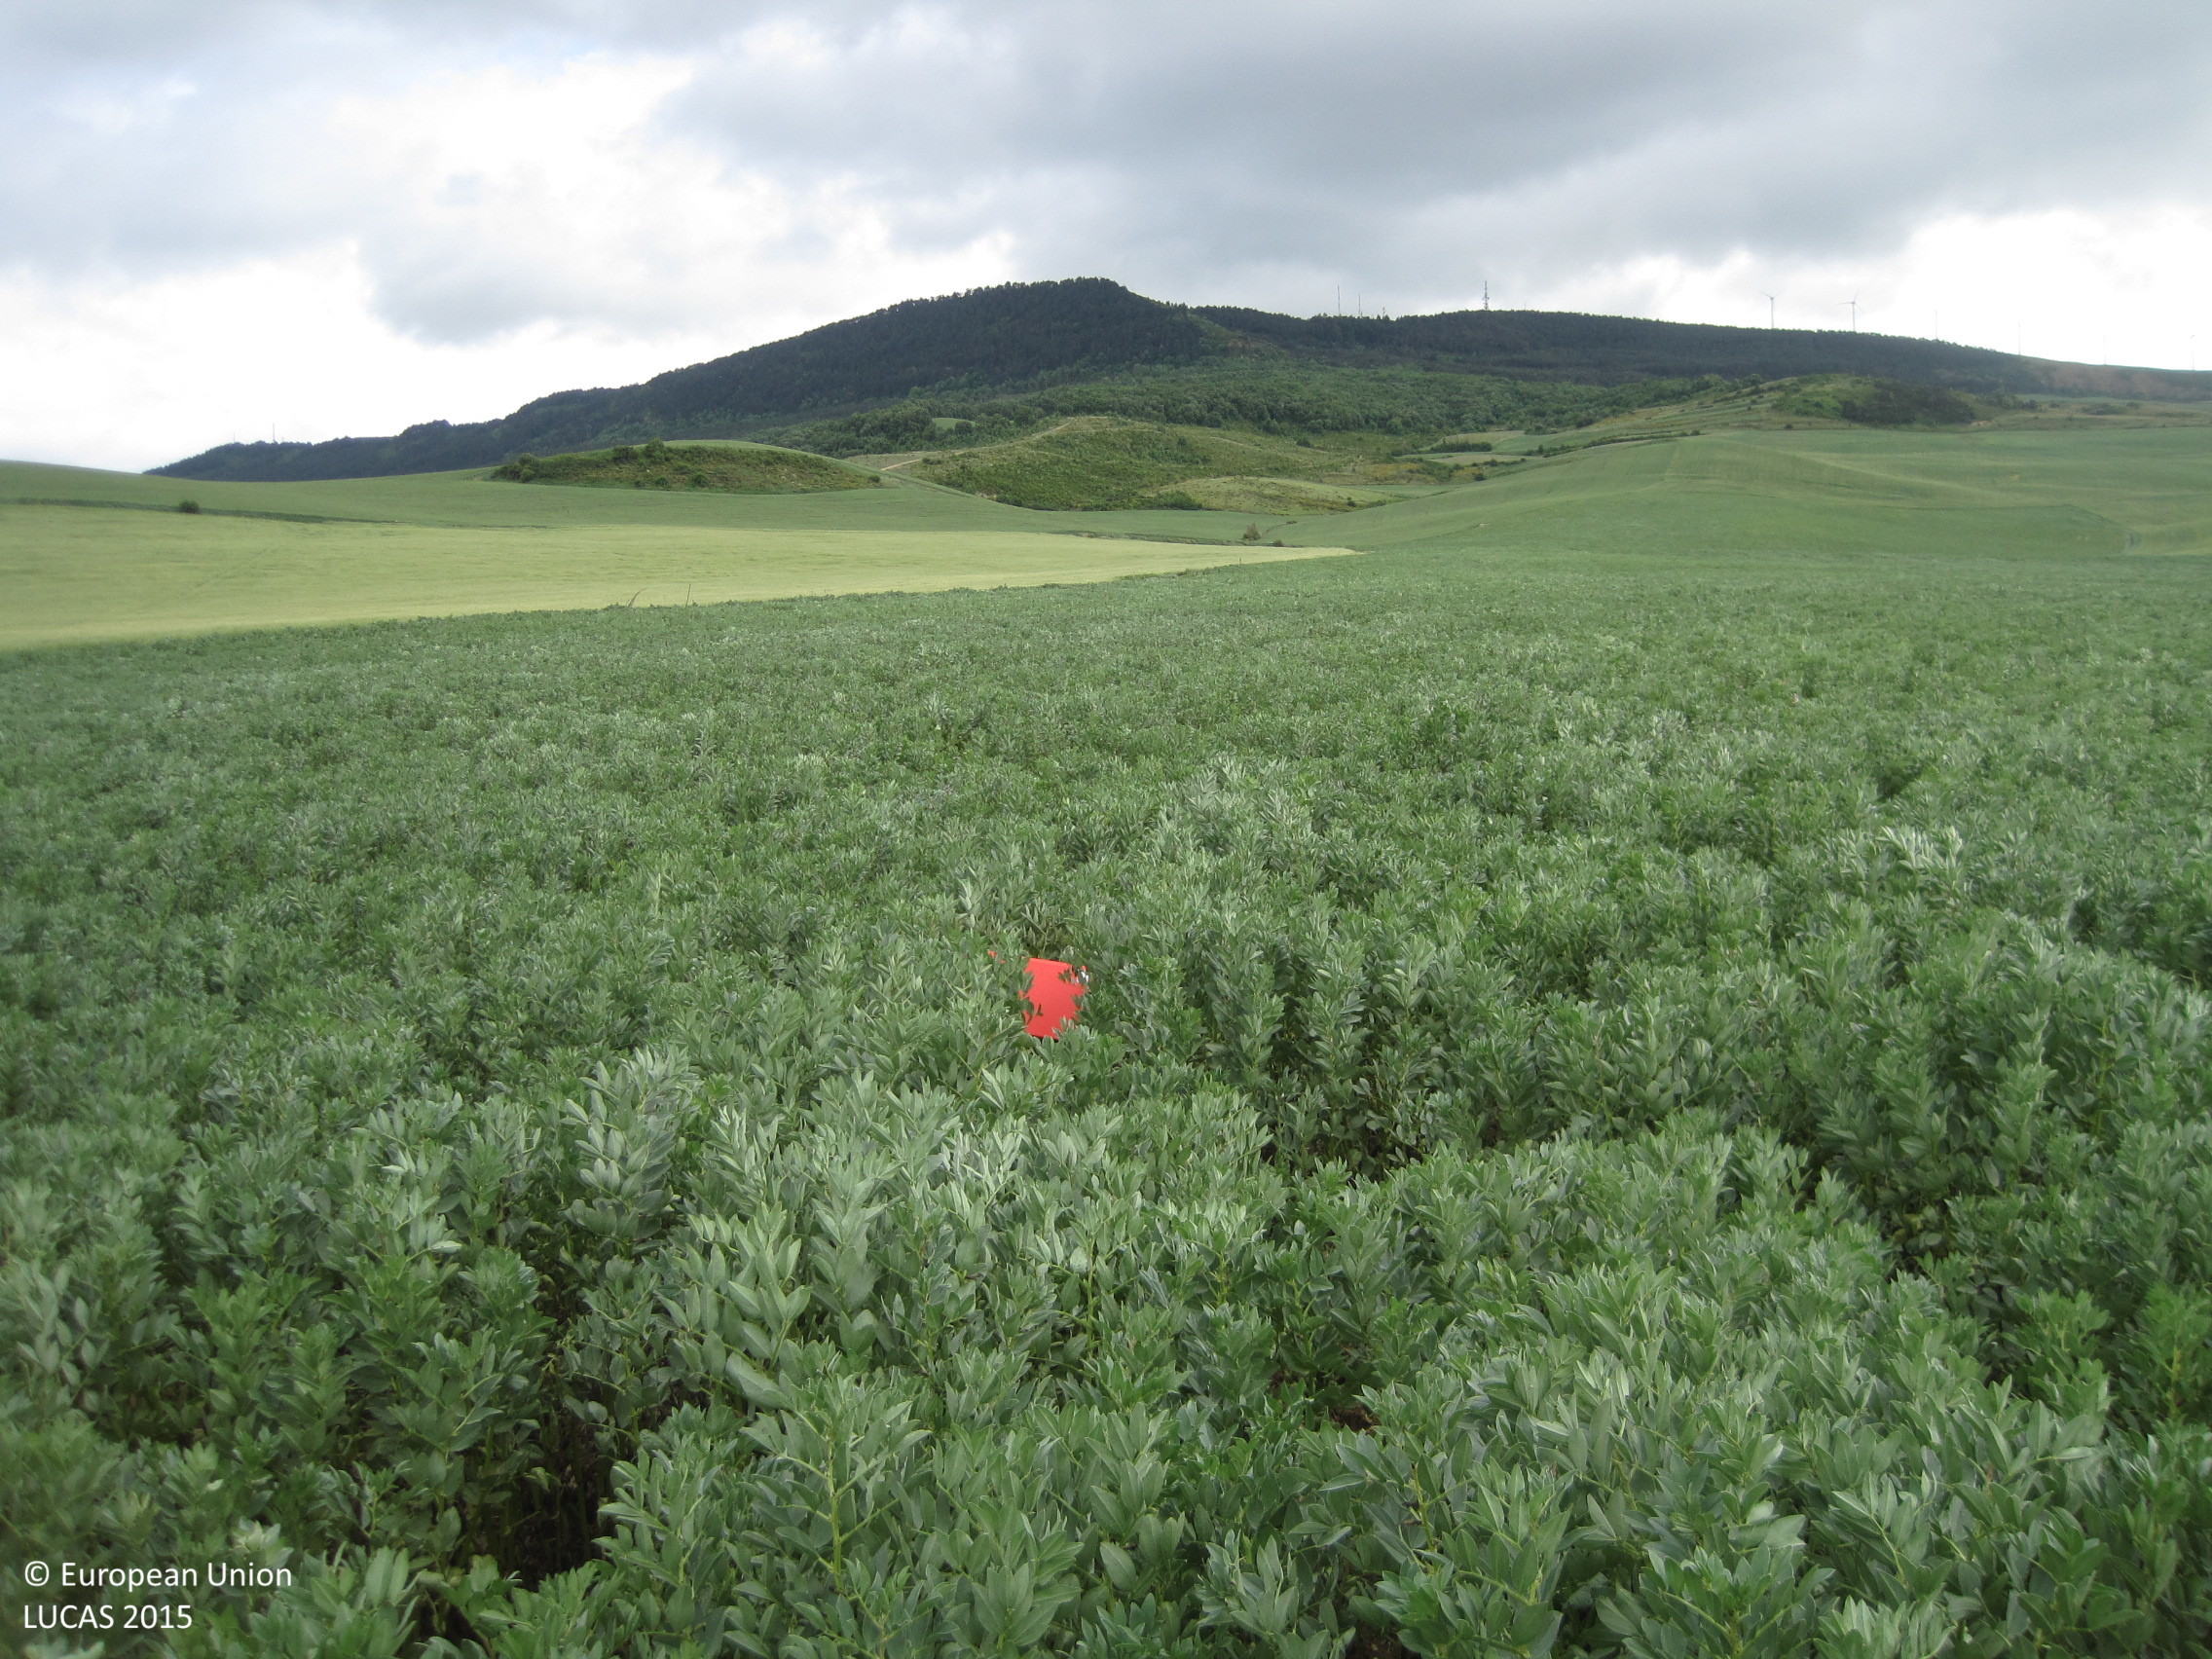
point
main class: Cropland
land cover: Dry pulses
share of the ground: > 75 %
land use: Agriculture (excluding fallow land and kitchen gardens)
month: May
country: ES
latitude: 42.7563
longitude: -1.7079
